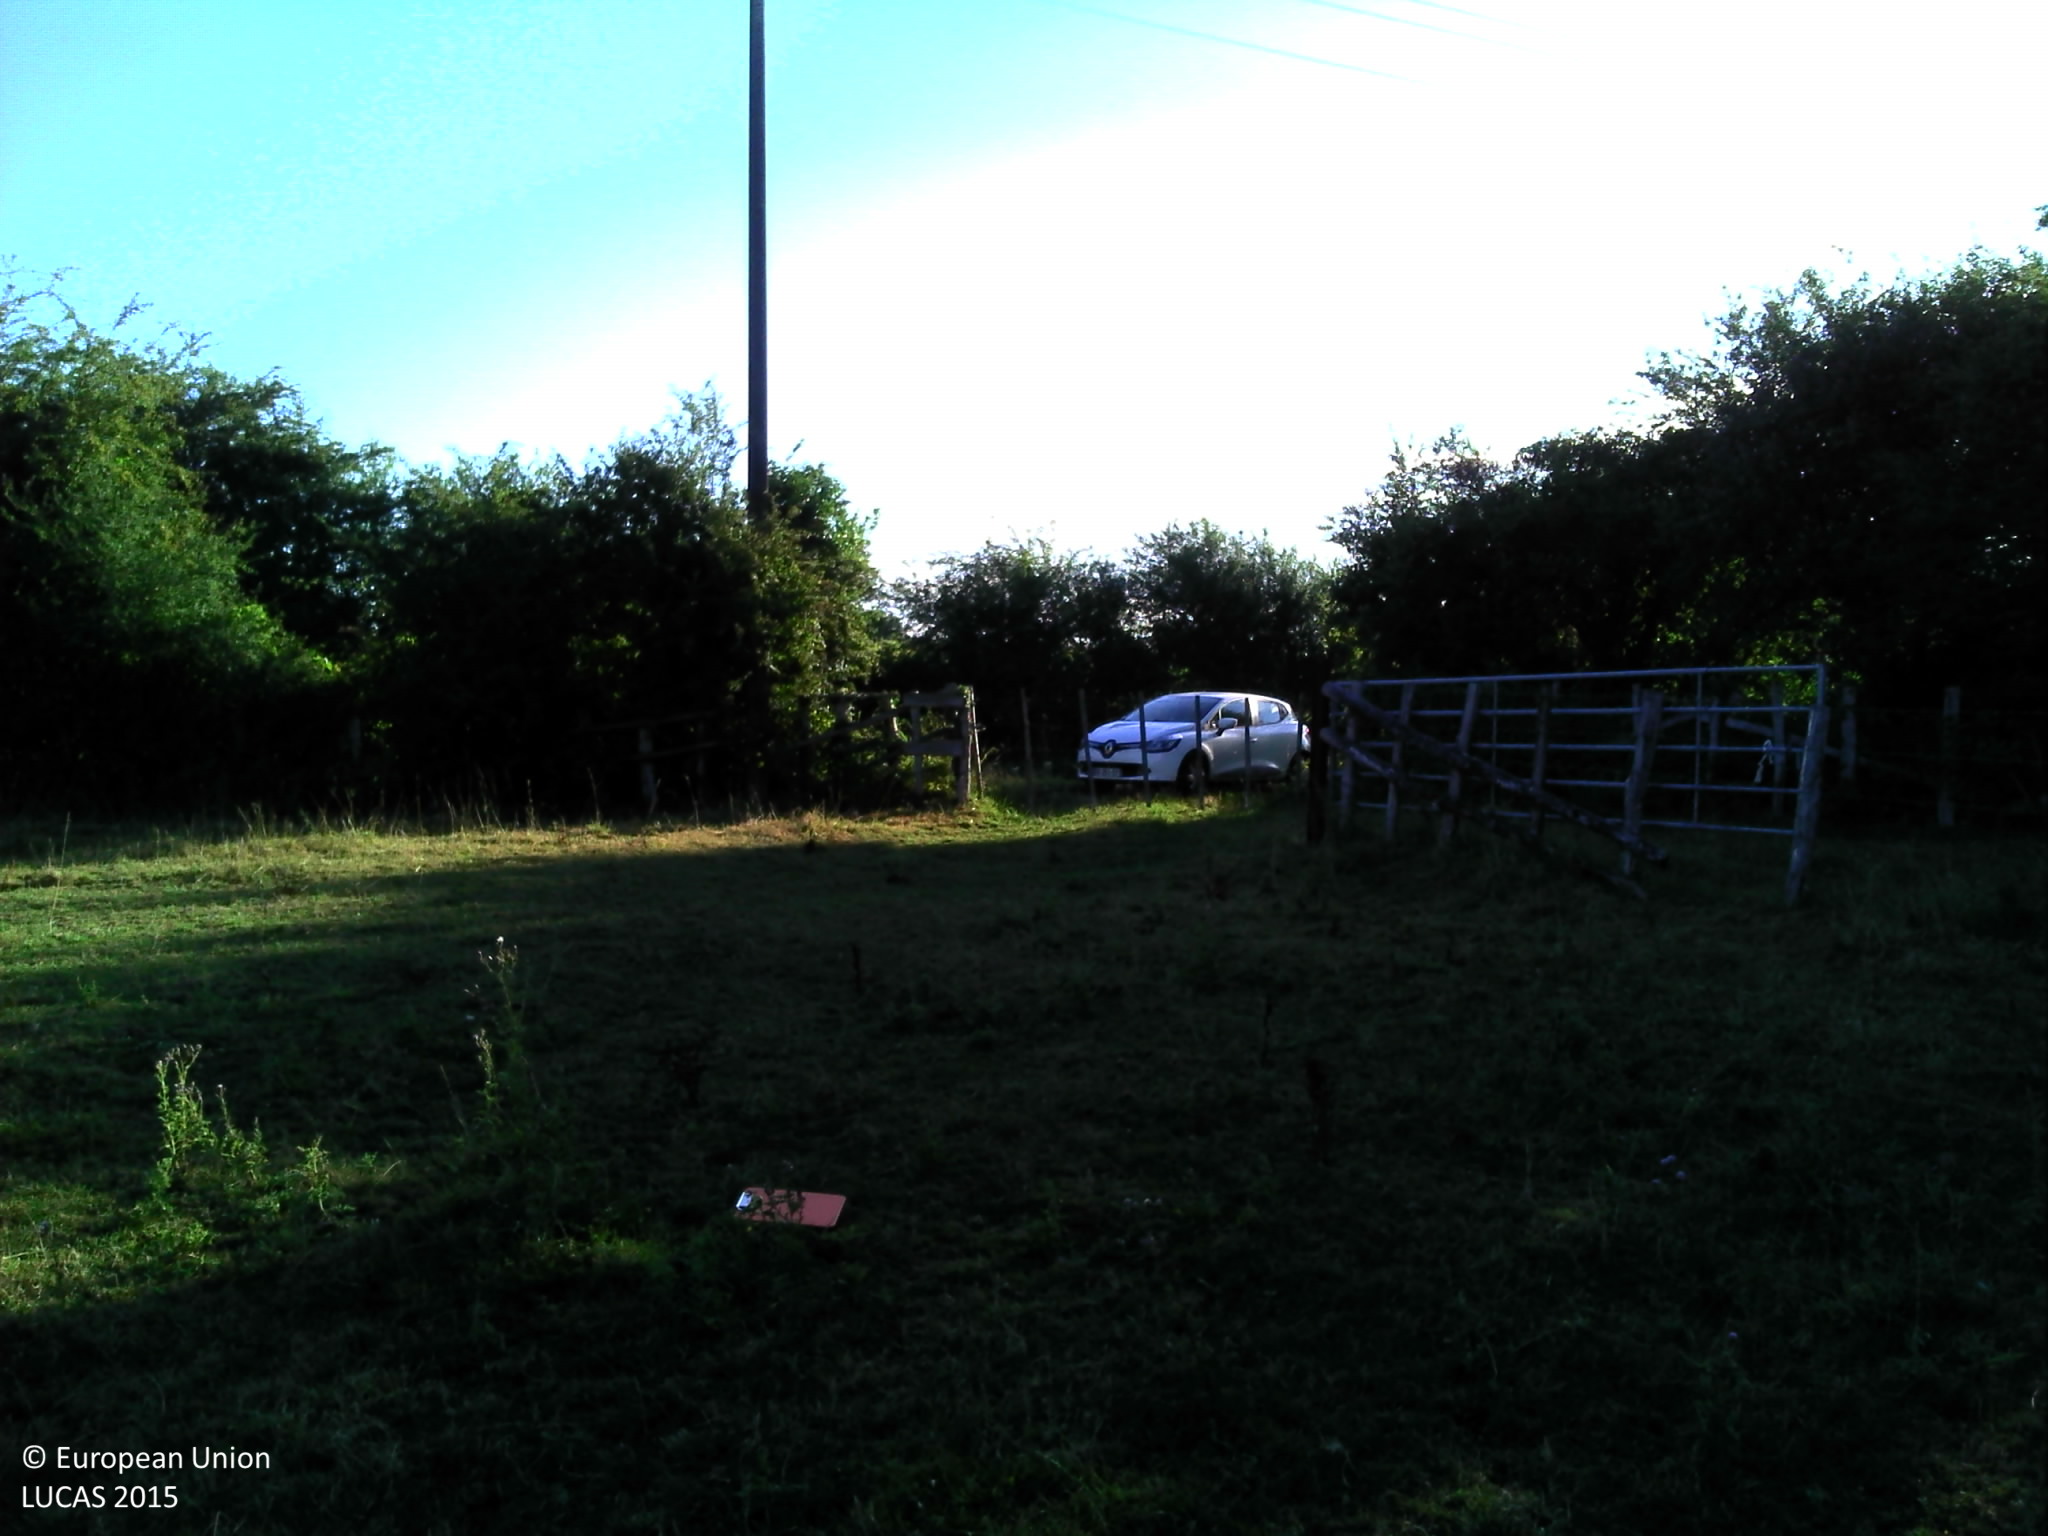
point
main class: Grassland
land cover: Grassland without tree/shrub cover
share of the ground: > 75 %
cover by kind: herbaceous plants 100 %
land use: Agriculture (excluding fallow land and kitchen gardens)
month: July
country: FR
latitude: 47.4768
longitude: -1.9783
